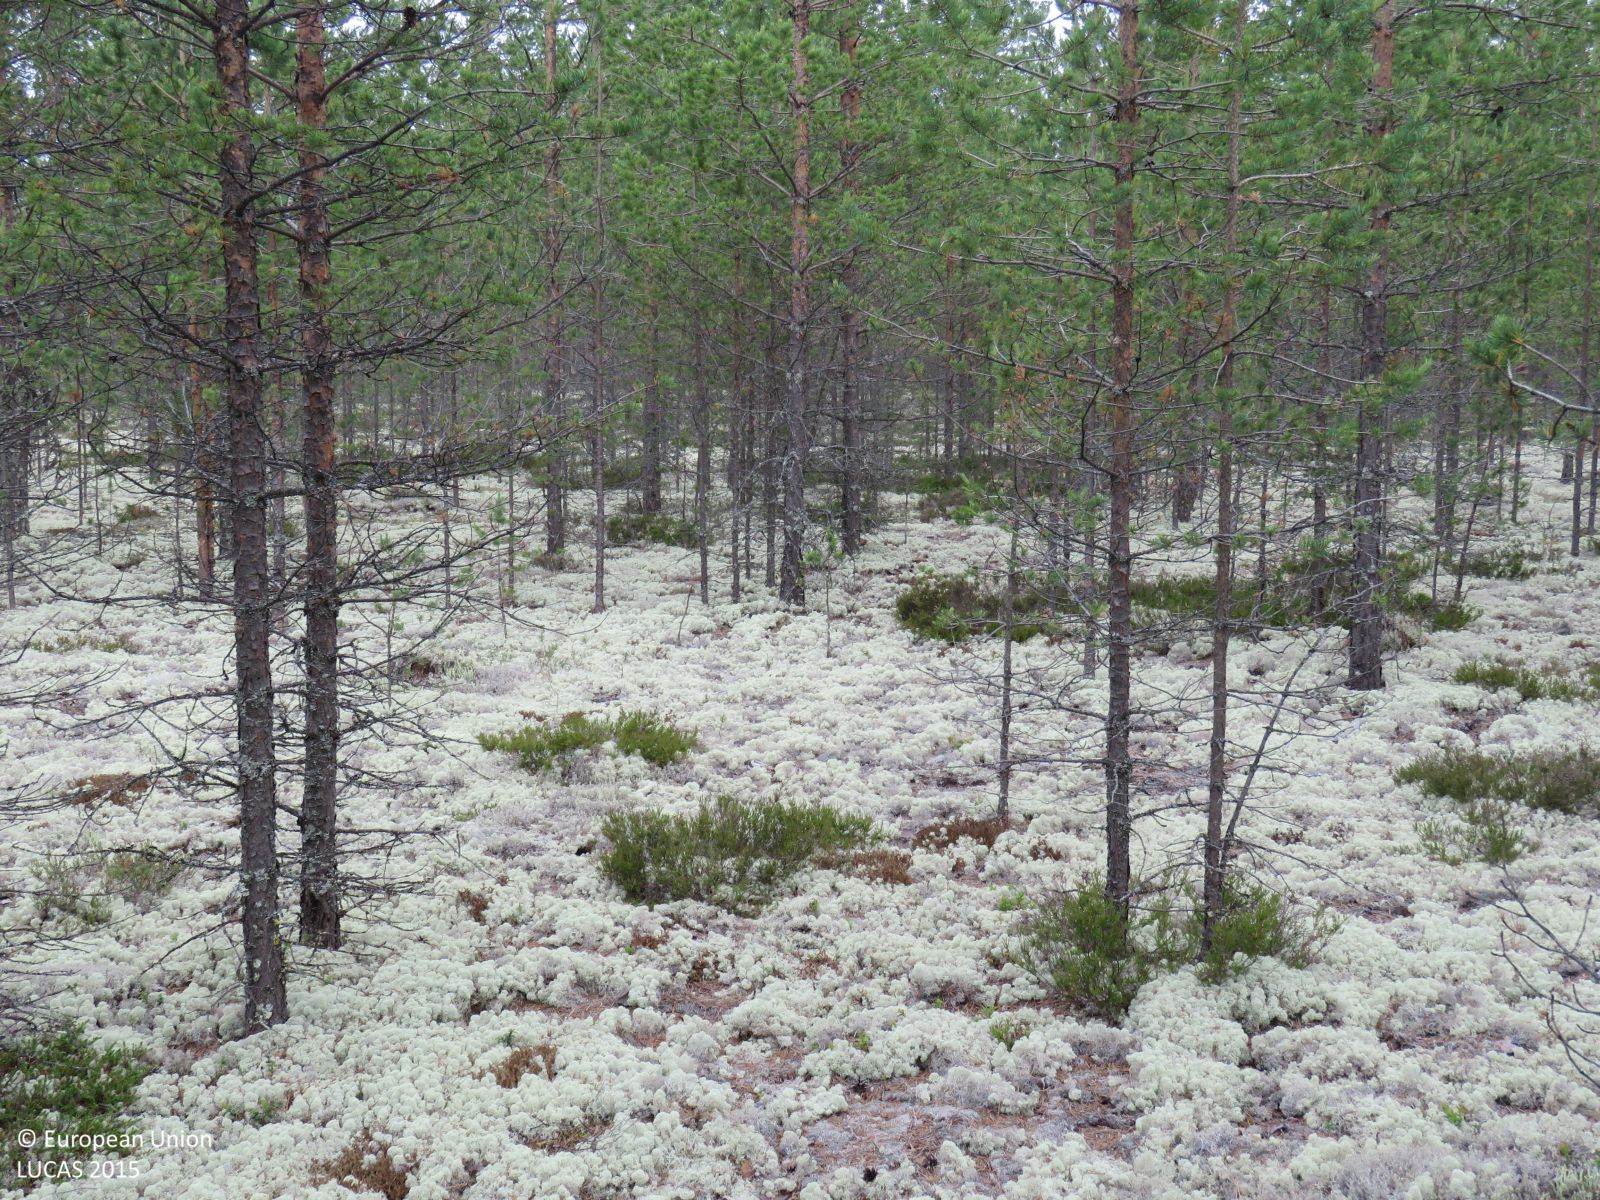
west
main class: Woodland
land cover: Pine dominated coniferous woodland
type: boreal forest
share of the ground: 50 - 75 %
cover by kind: coniferous forest trees 50 %, lichens and mosses 35 %, shrubs 10 %, unconsolidated bare surface 5 %
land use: Forestry
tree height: > 5 m
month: July
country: FI
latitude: 64.4822
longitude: 26.7446
